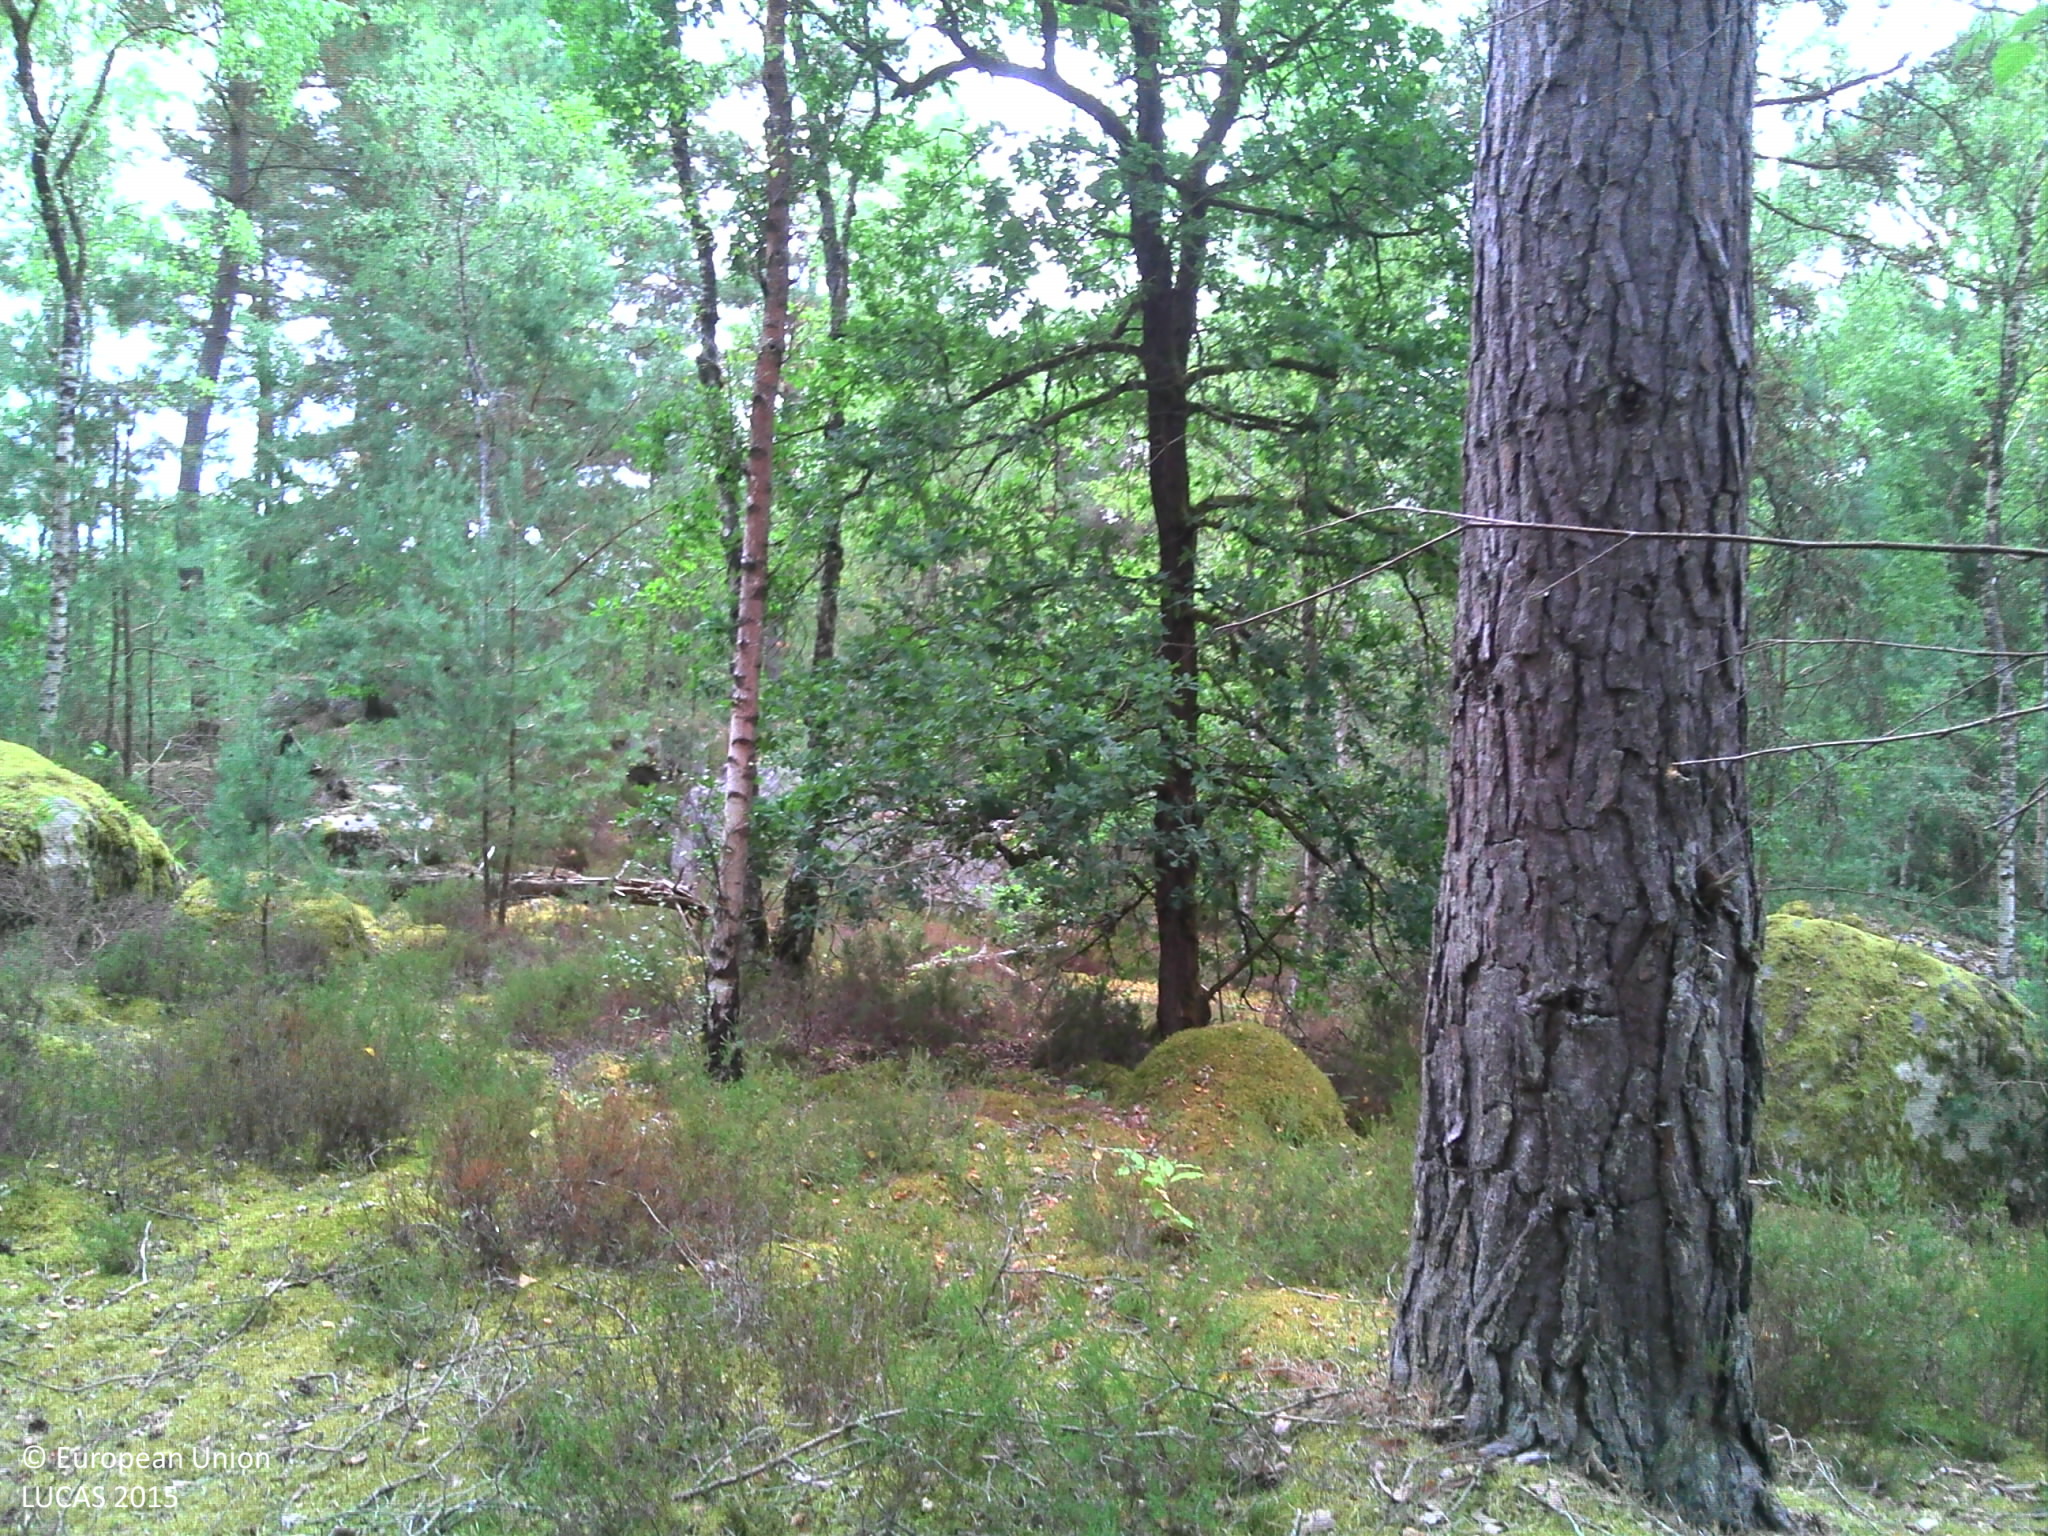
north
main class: Woodland
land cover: Pine dominated mixed woodland
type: non-riverine alder, birch or aspen forest
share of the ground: > 75 %
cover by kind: lichens and mosses 40 %, coniferous forest trees 30 %, shrubs 20 %, broadleaved forest trees 10 %
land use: Forestry
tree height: > 5 m
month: August
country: FR
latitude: 48.3671
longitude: 2.5251
